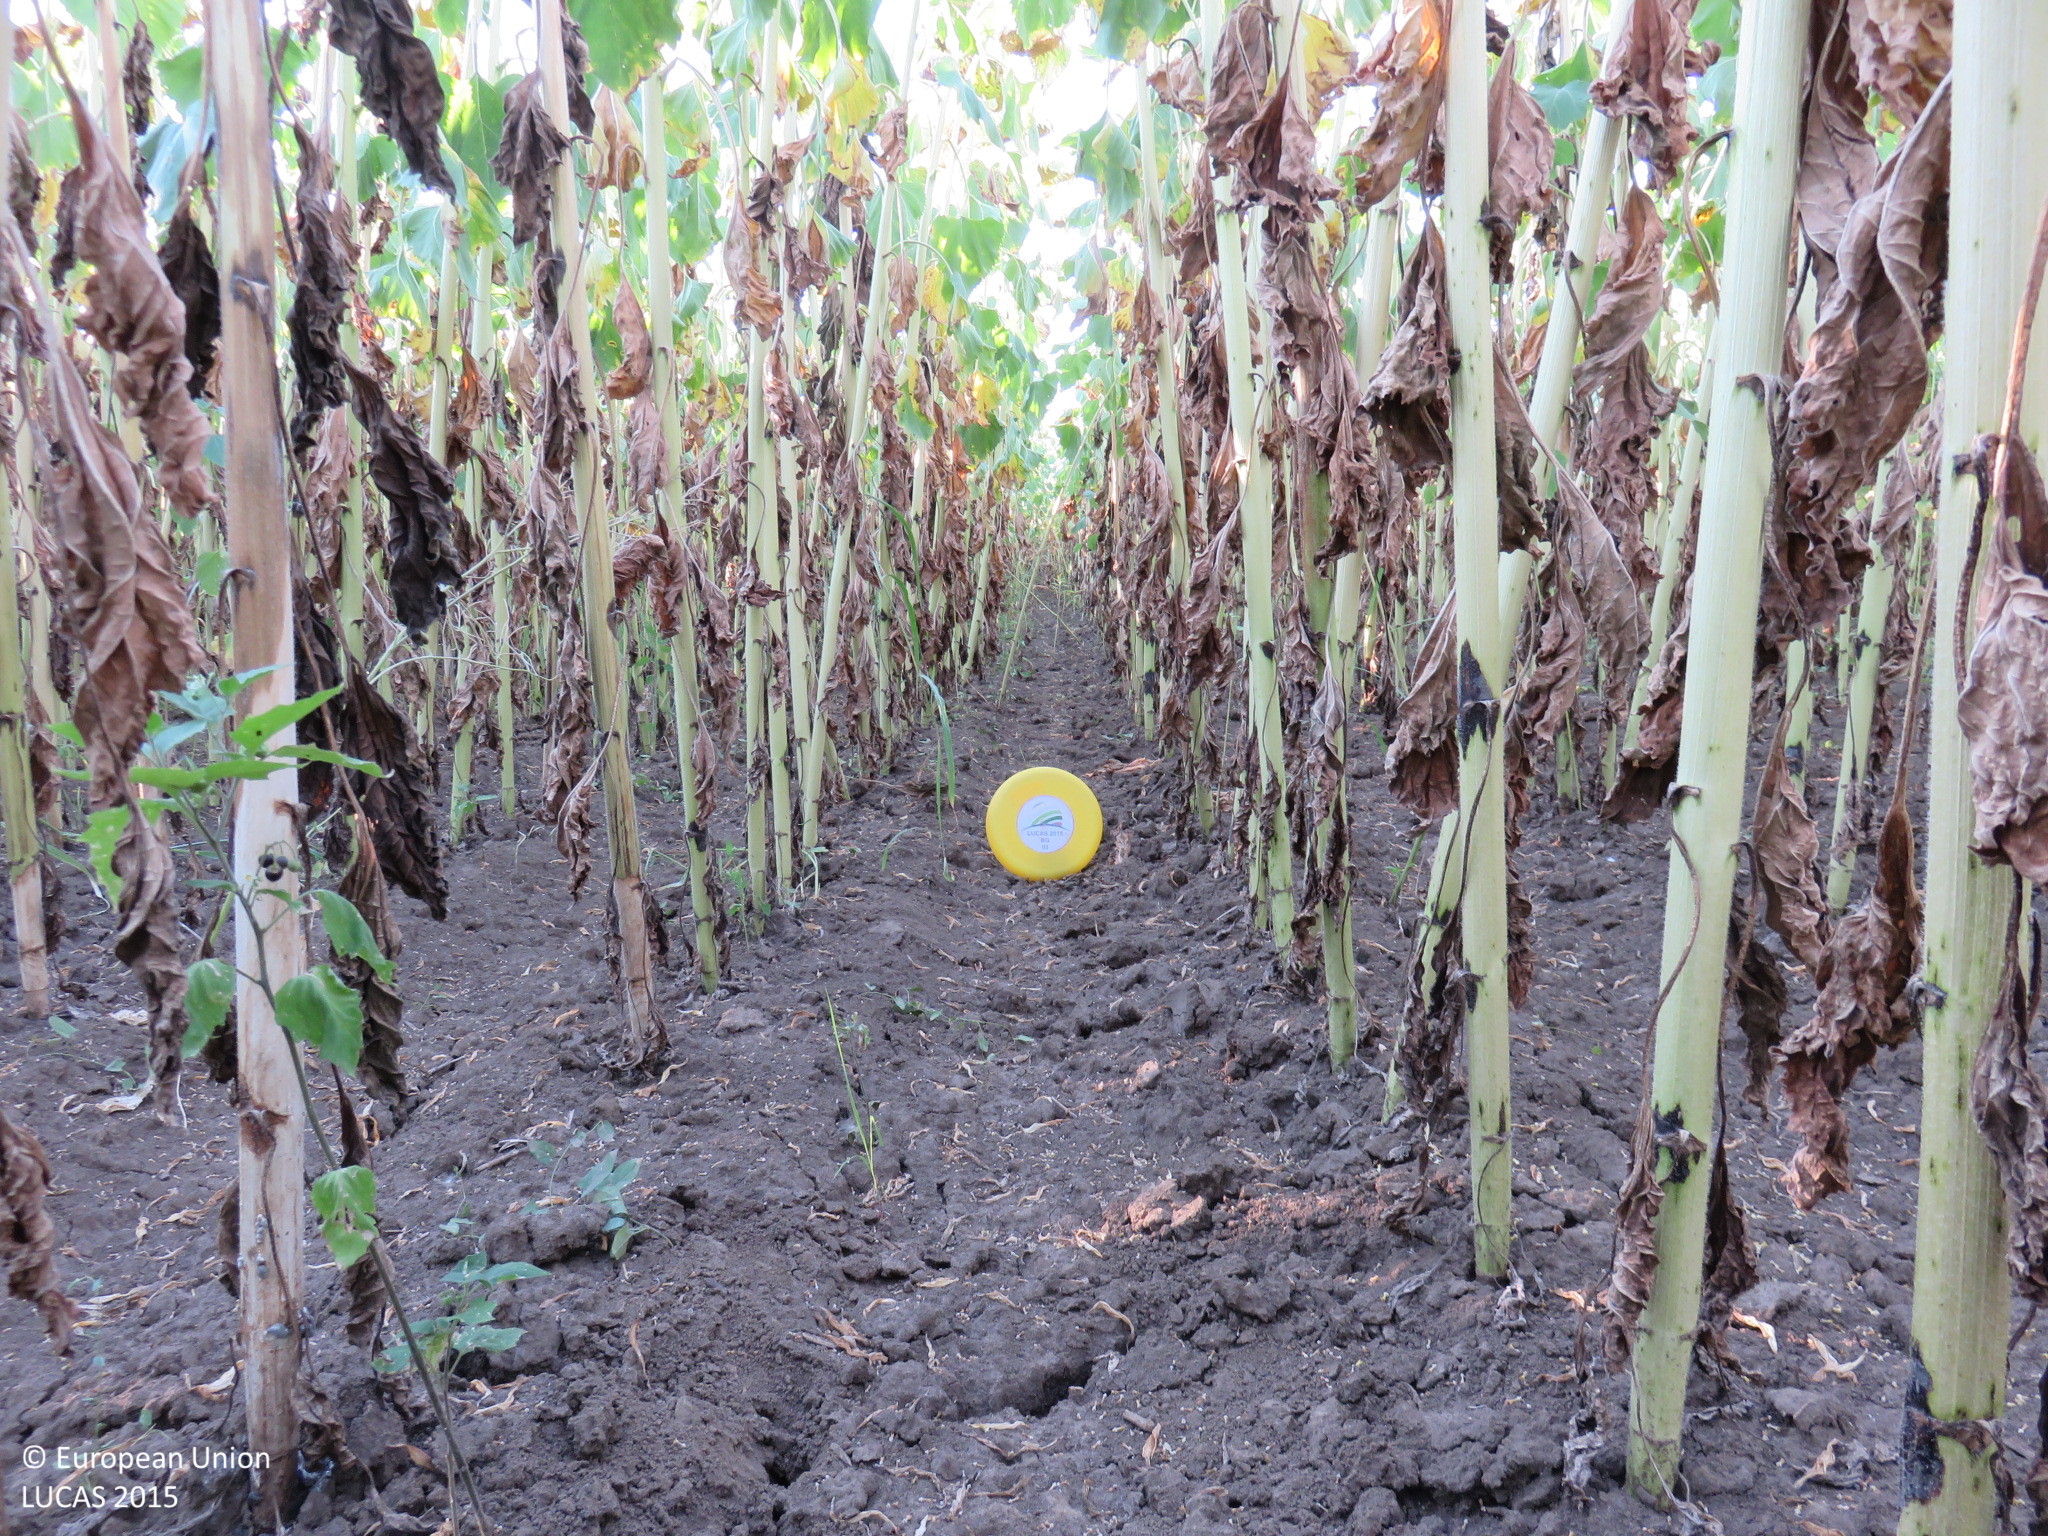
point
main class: Cropland
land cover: Sunflower
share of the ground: > 75 %
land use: Agriculture (excluding fallow land and kitchen gardens)
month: July
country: BG
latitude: 43.3642
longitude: 25.1143
